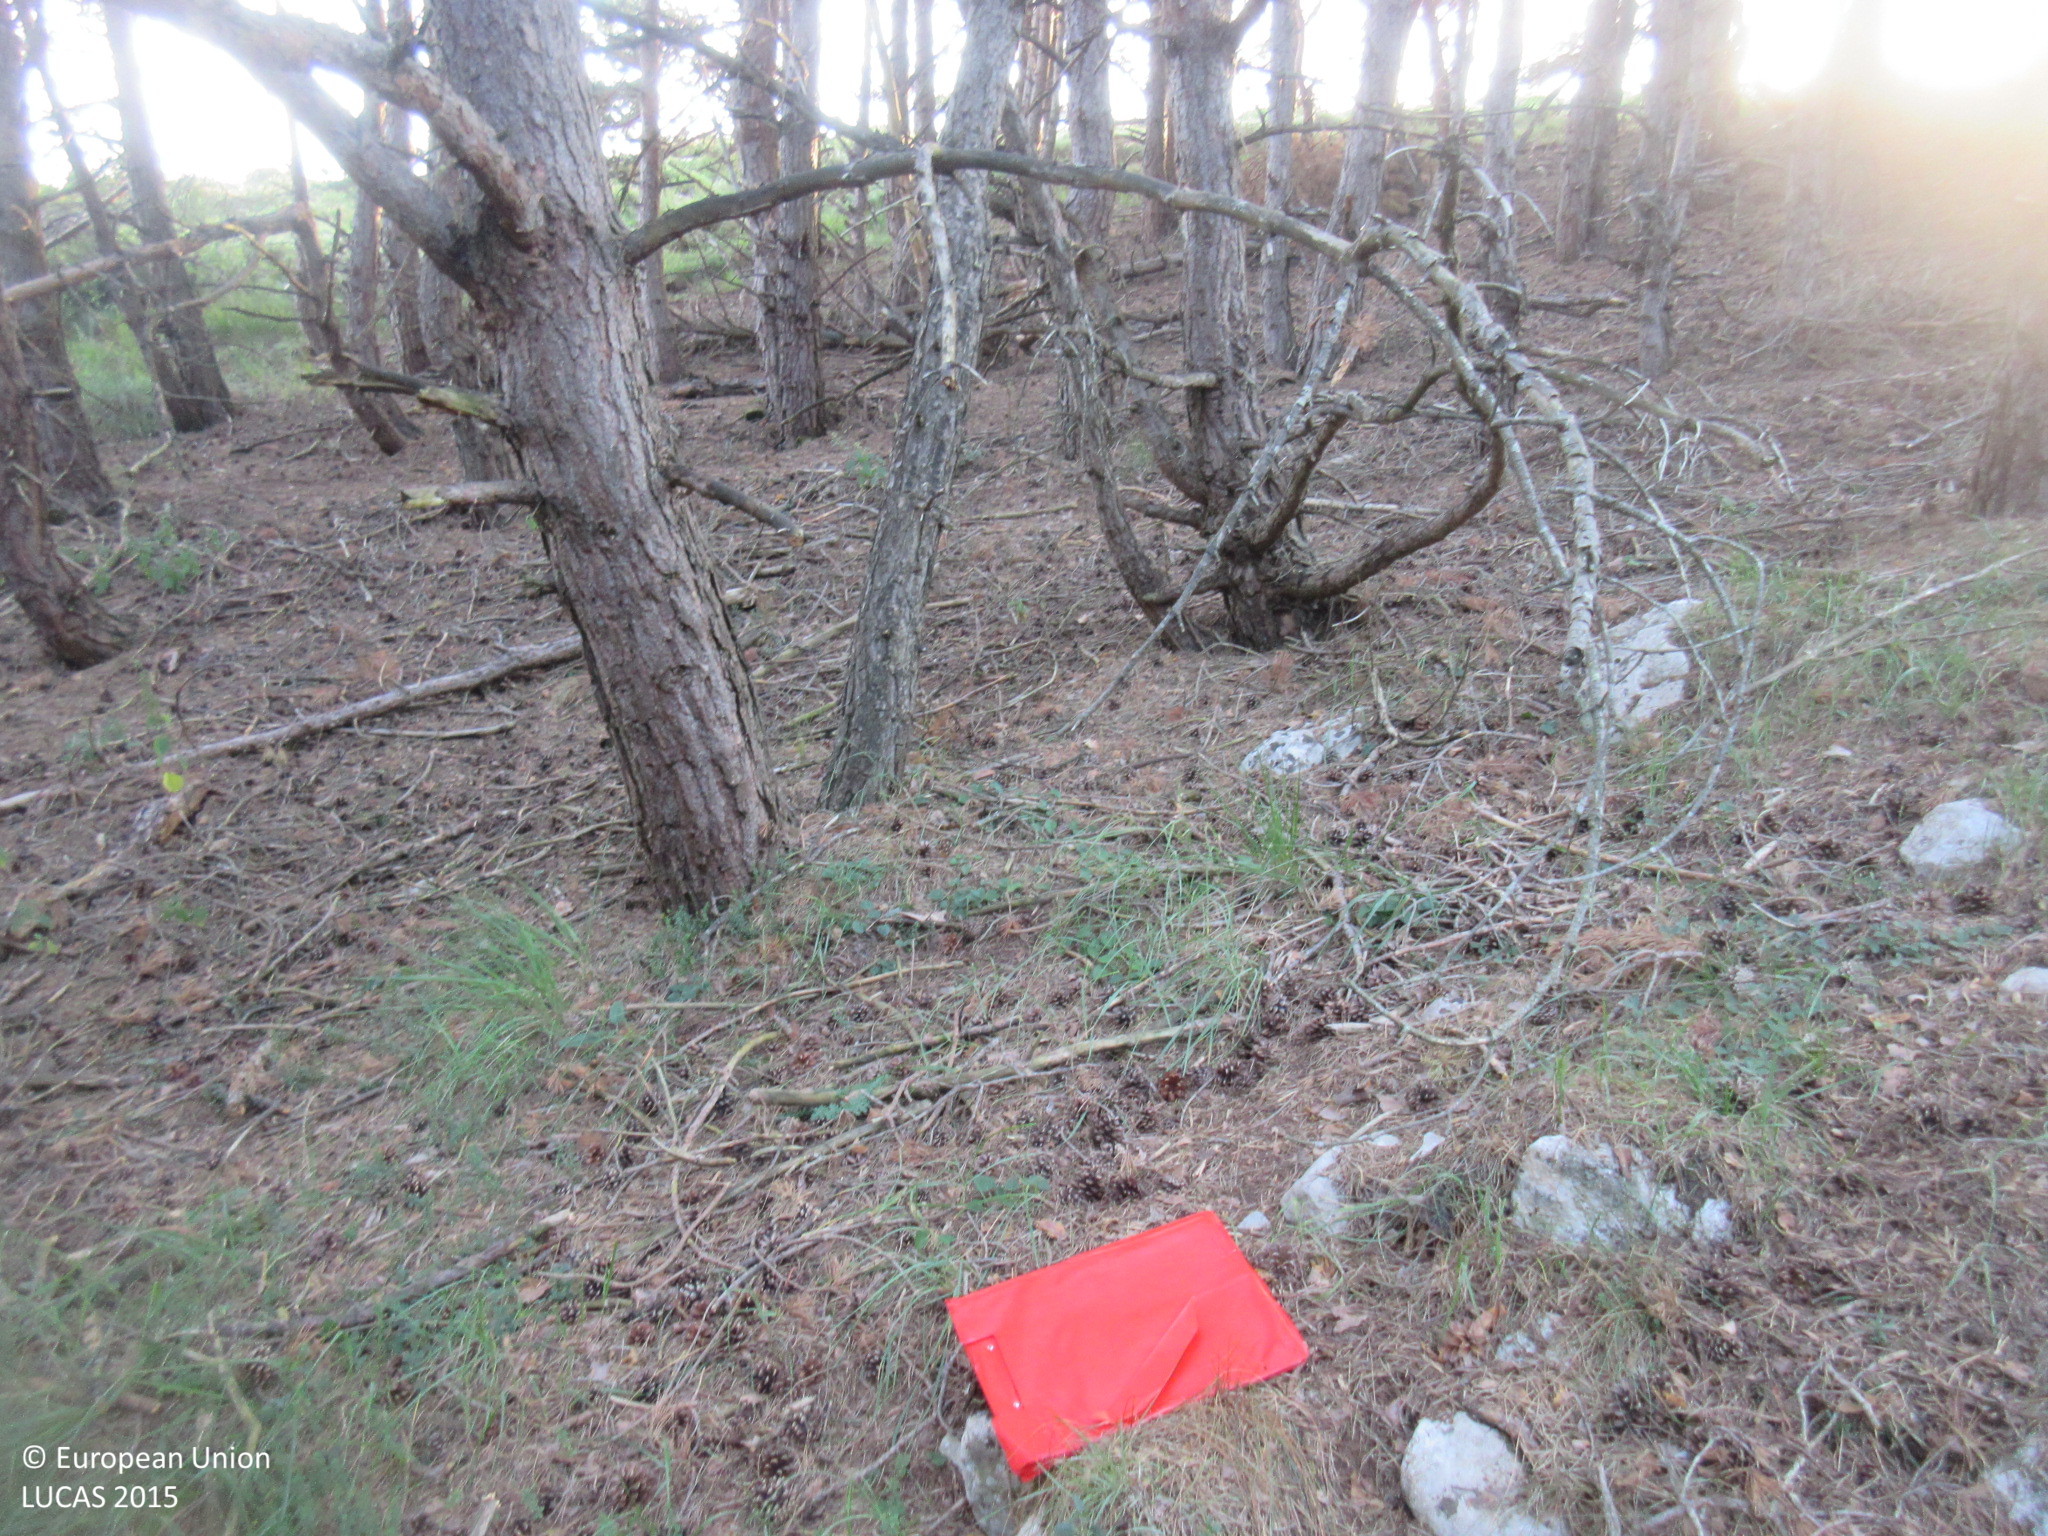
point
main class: Woodland
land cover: Pine dominated coniferous woodland
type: hemiboreal forest and nemoral coniferous forest and mixed broadleaved-coniferous forest
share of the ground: > 75 %
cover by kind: coniferous forest trees 90 %, shrubs 10 %
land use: Forestry
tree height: > 5 m
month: July
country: ES
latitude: 43.0394
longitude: -3.5305
